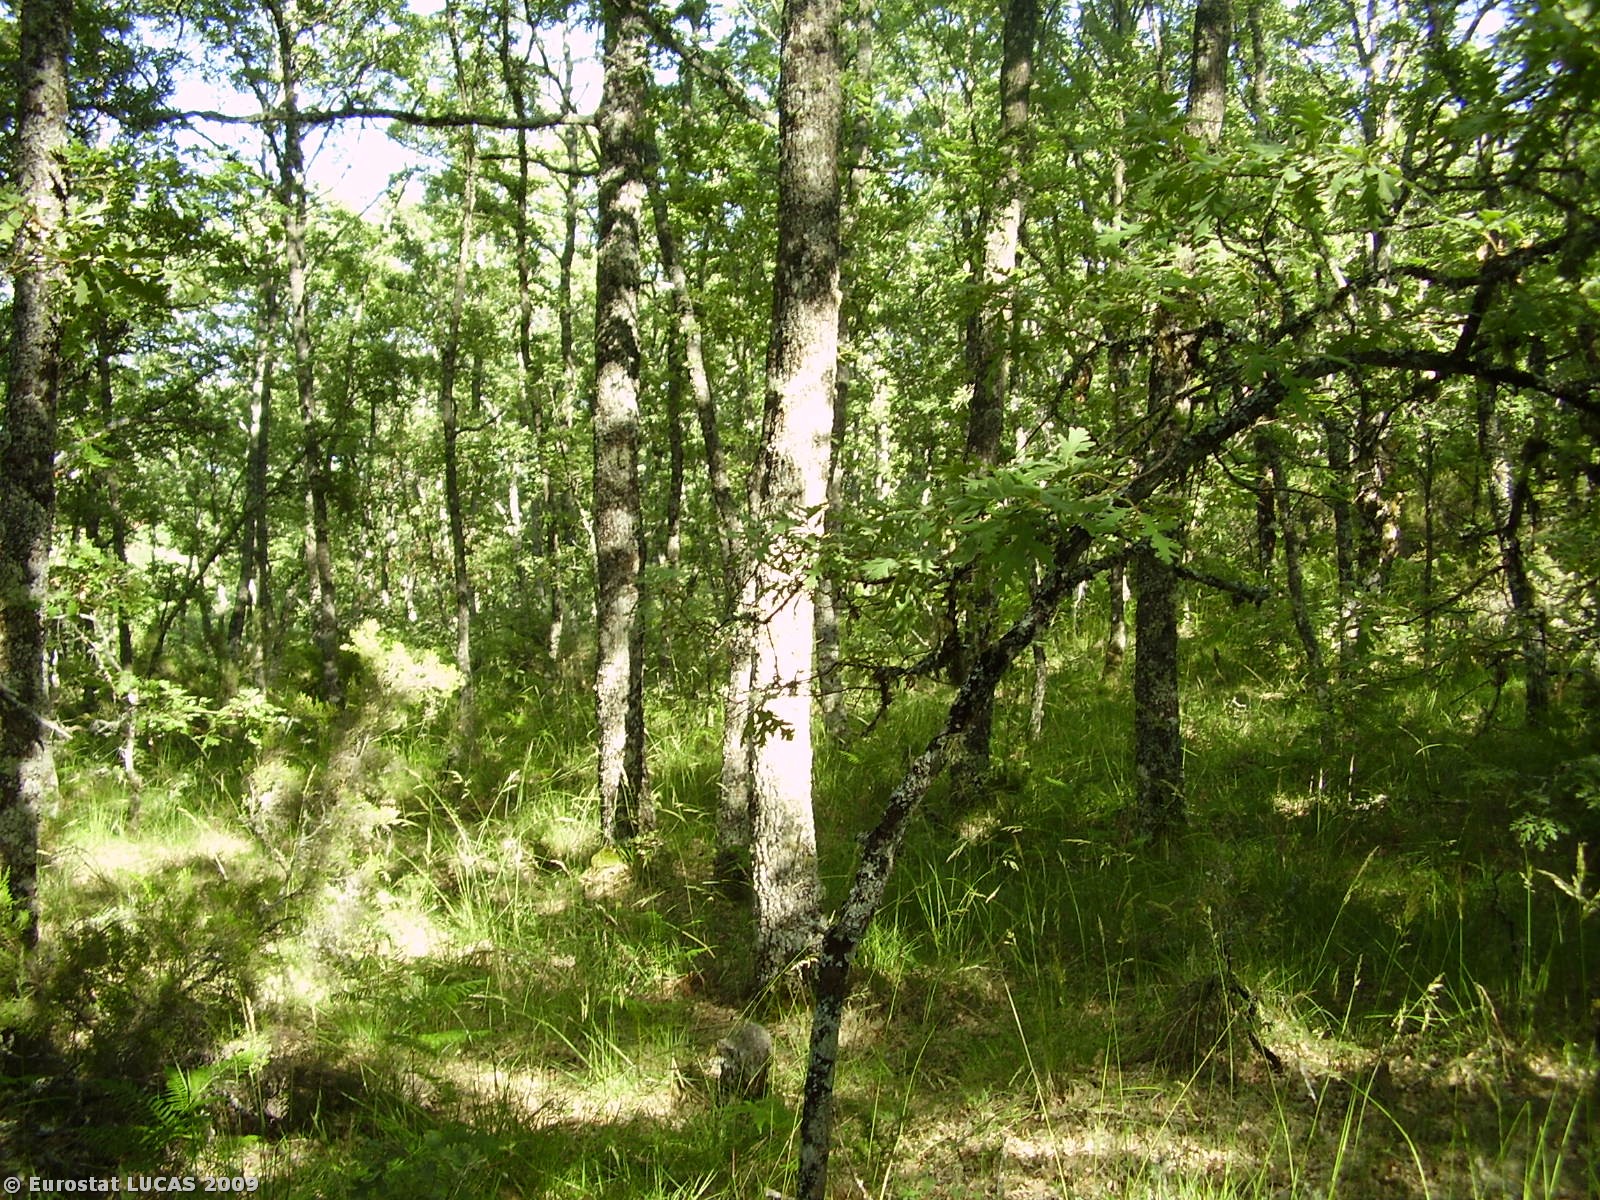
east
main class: Woodland
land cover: Broadleaved woodland
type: thermophilous deciduous forest
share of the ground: 50 - 75 %
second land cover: Spontaneously vegetated surfaces
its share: 25 - 50 %
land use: Forestry
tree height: > 5 m
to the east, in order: Broadleaved woodland; Spontaneously vegetated surfaces; Broadleaved woodland; Other structural elements; Tracks; Managed hedges; Ditches and canals; Managed hedges; Nuts trees; Abandoned hedges; Tracks; Abandoned hedges; Grassland without tree/shrub cover; Spontaneously vegetated surfaces; Ditches and canals; Grassland without tree/shrub cover; Ditches and canals; Grassland without tree/shrub cover; Ditches and canals; Grassland without tree/shrub cover
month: June
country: PT
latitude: 41.8541
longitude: -6.9705
